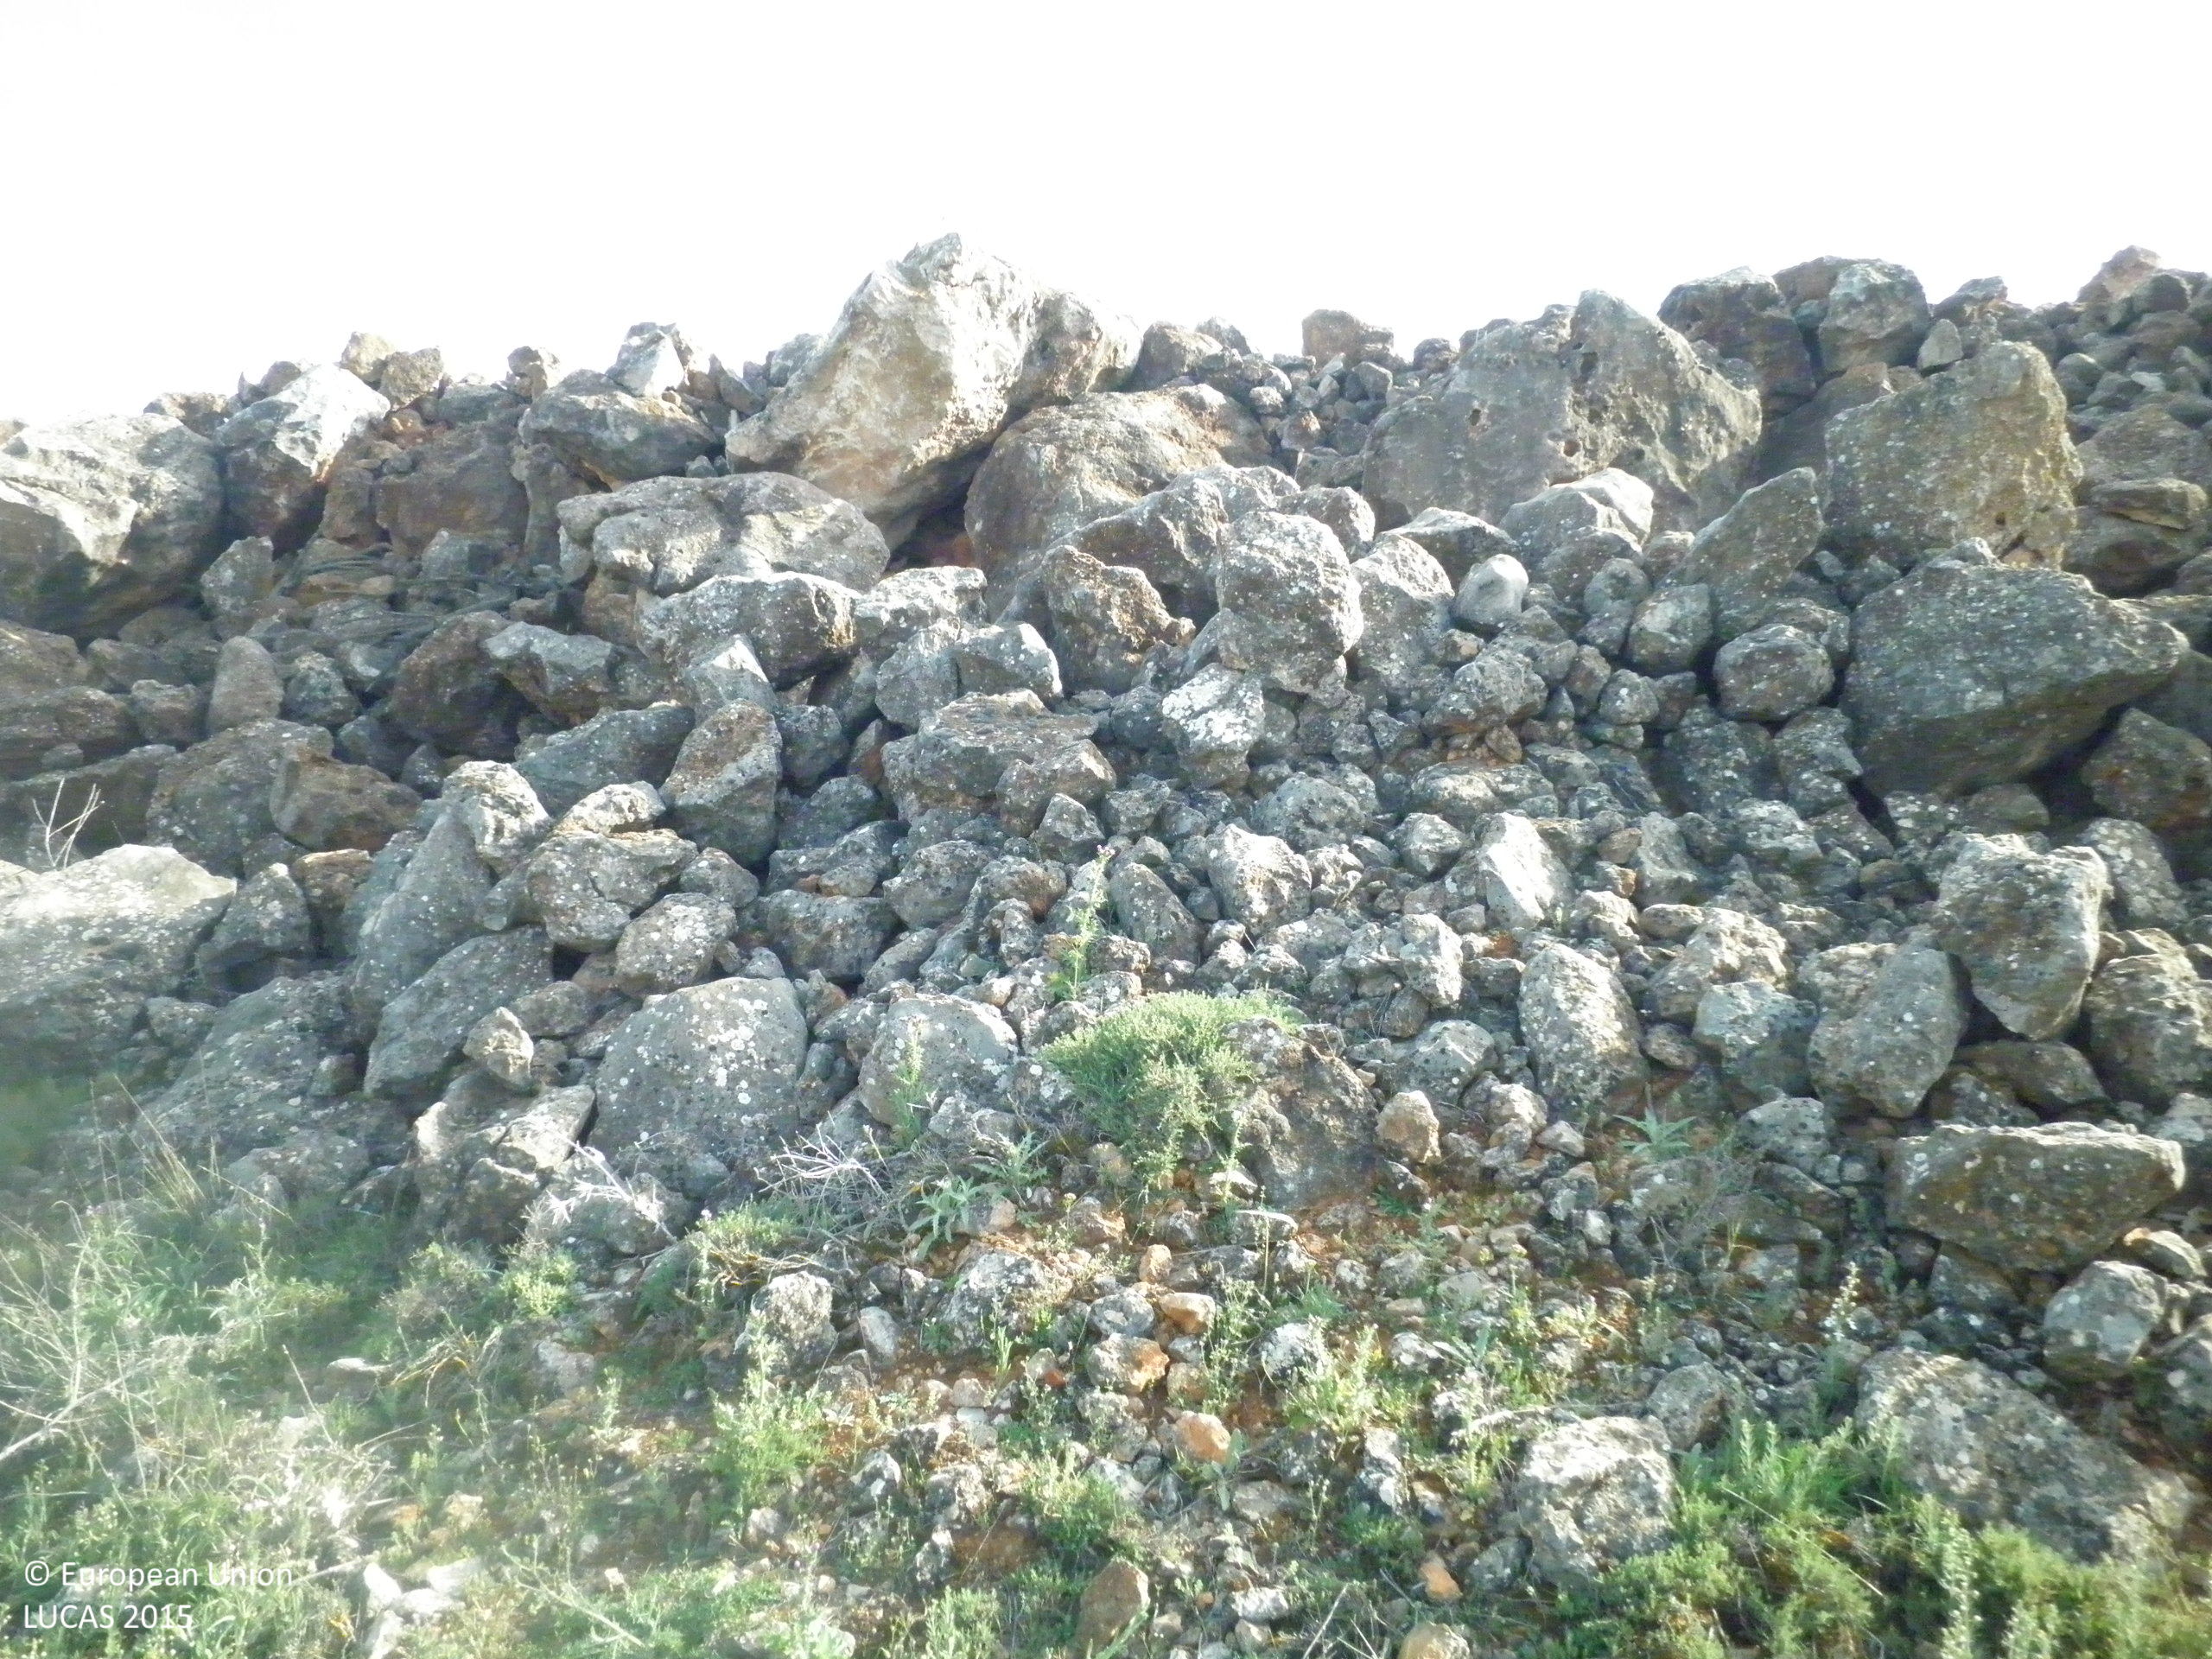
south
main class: Grassland
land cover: Grassland without tree/shrub cover
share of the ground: 25 - 50 %
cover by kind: herbaceous plants 45 %, consolidated bare surface 25 %, unconsolidated bare surface 25 %, shrubs 5 %
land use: Semi-natural and natural areas not in use
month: May
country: ES
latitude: 39.6268
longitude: -2.7968
